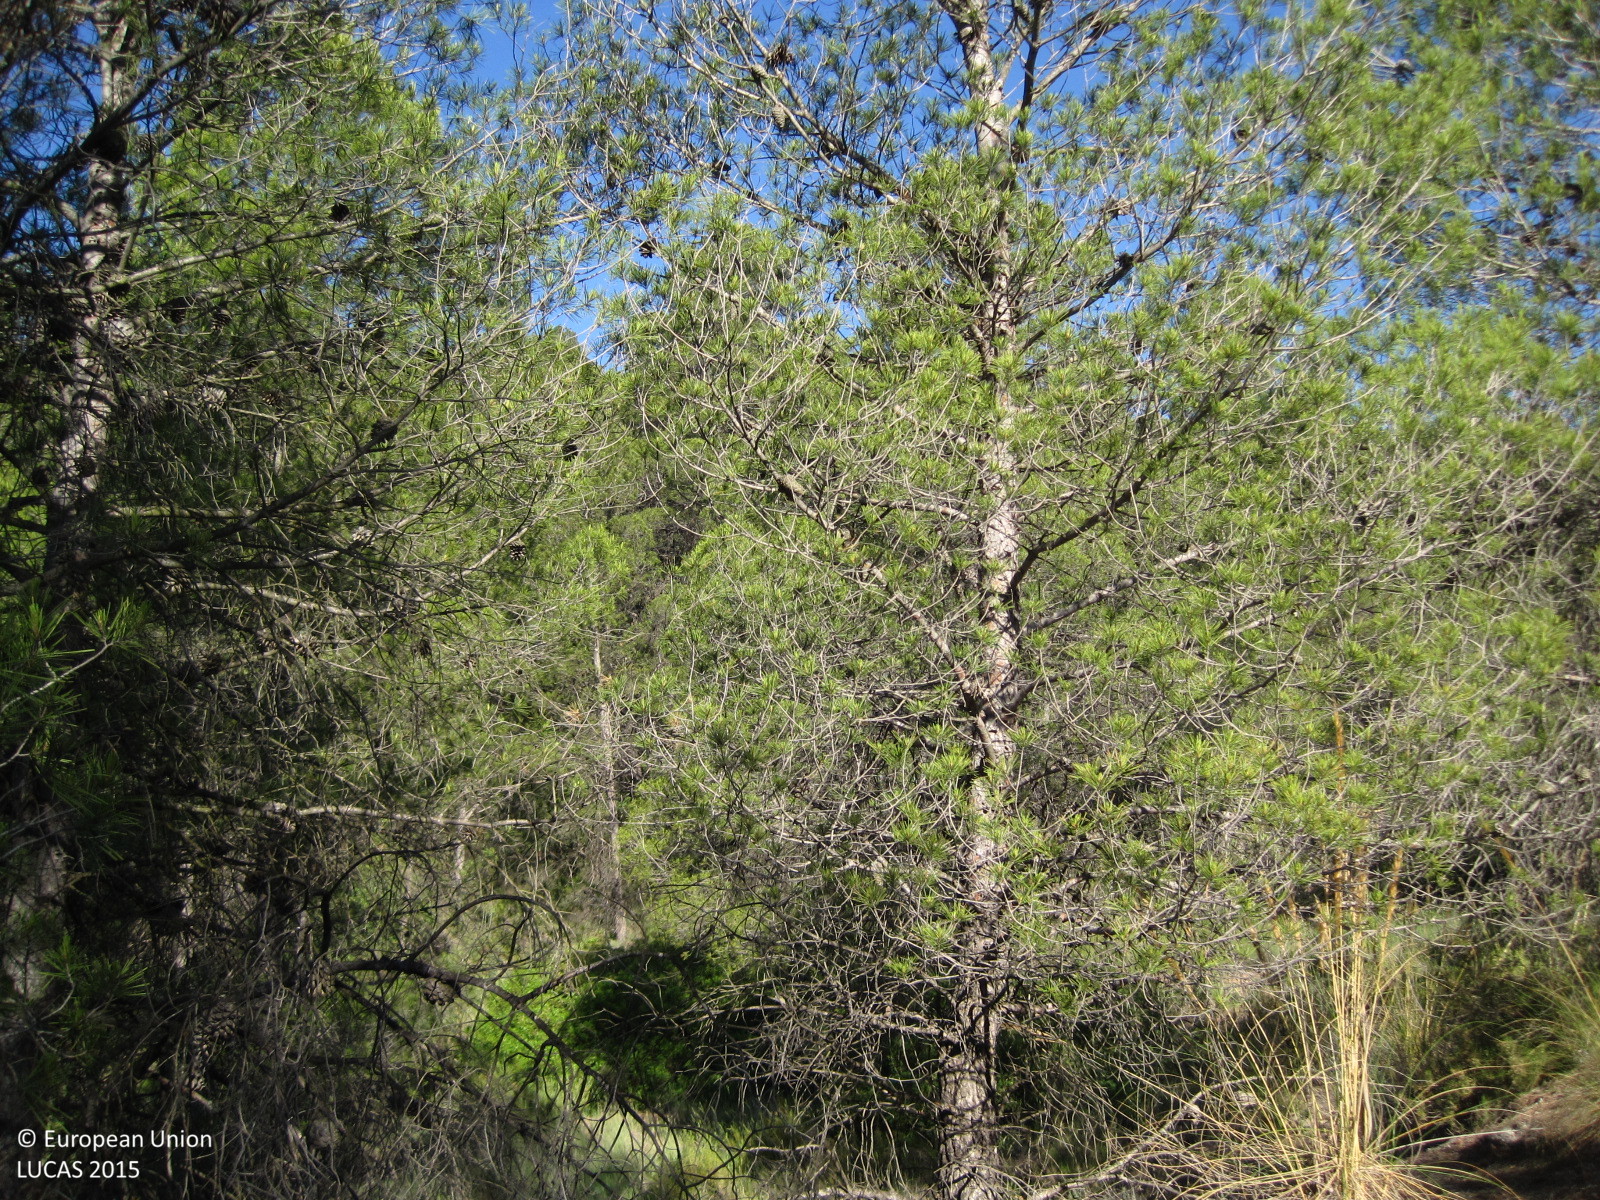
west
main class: Woodland
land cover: Pine dominated coniferous woodland
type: coniferous forest of the mediterranean region
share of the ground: 10 - 25 %
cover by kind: shrubs 30 %, herbaceous plants 25 %, unconsolidated bare surface 25 %, coniferous forest trees 20 %
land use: Forestry
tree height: > 5 m
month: June
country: ES
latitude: 39.2766
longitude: -1.0457
